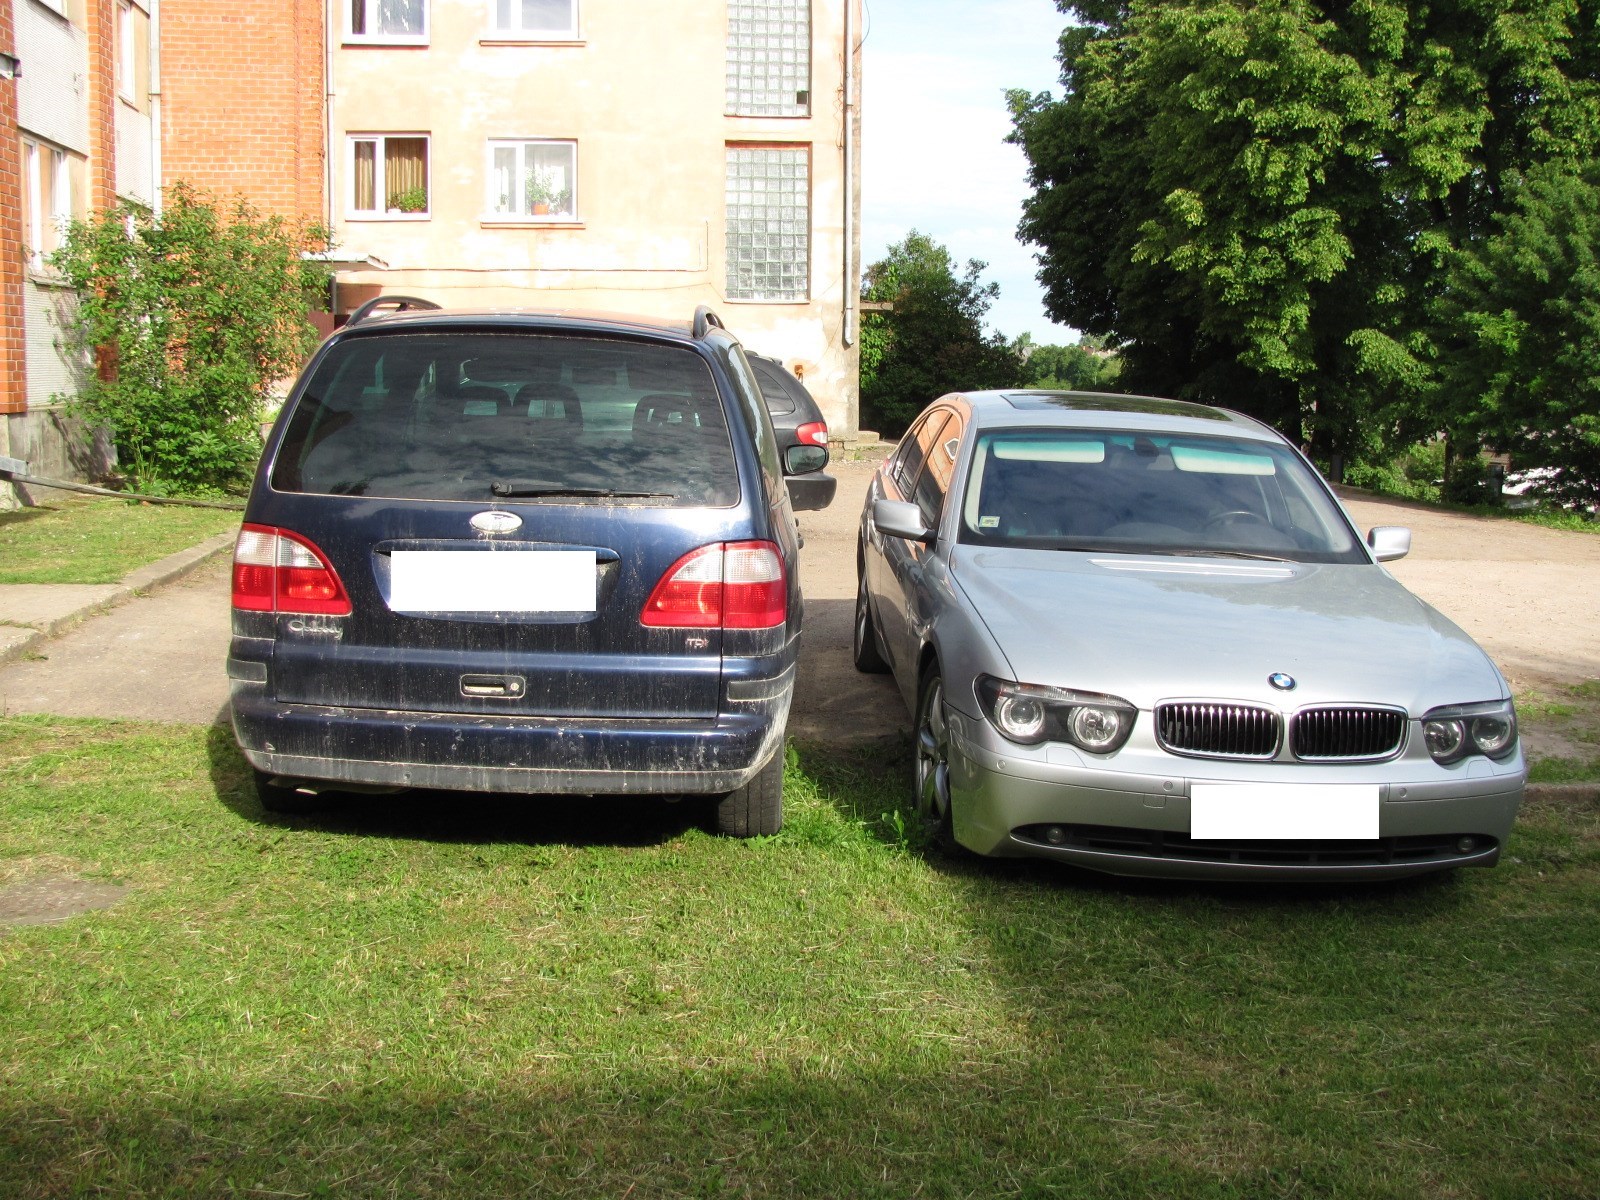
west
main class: Grassland
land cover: Grassland without tree/shrub cover
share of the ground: > 75 %
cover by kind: herbaceous plants 100 %
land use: Amenities, museums, leisure
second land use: Residential
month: June
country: LV
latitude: 56.3983
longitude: 24.2018
